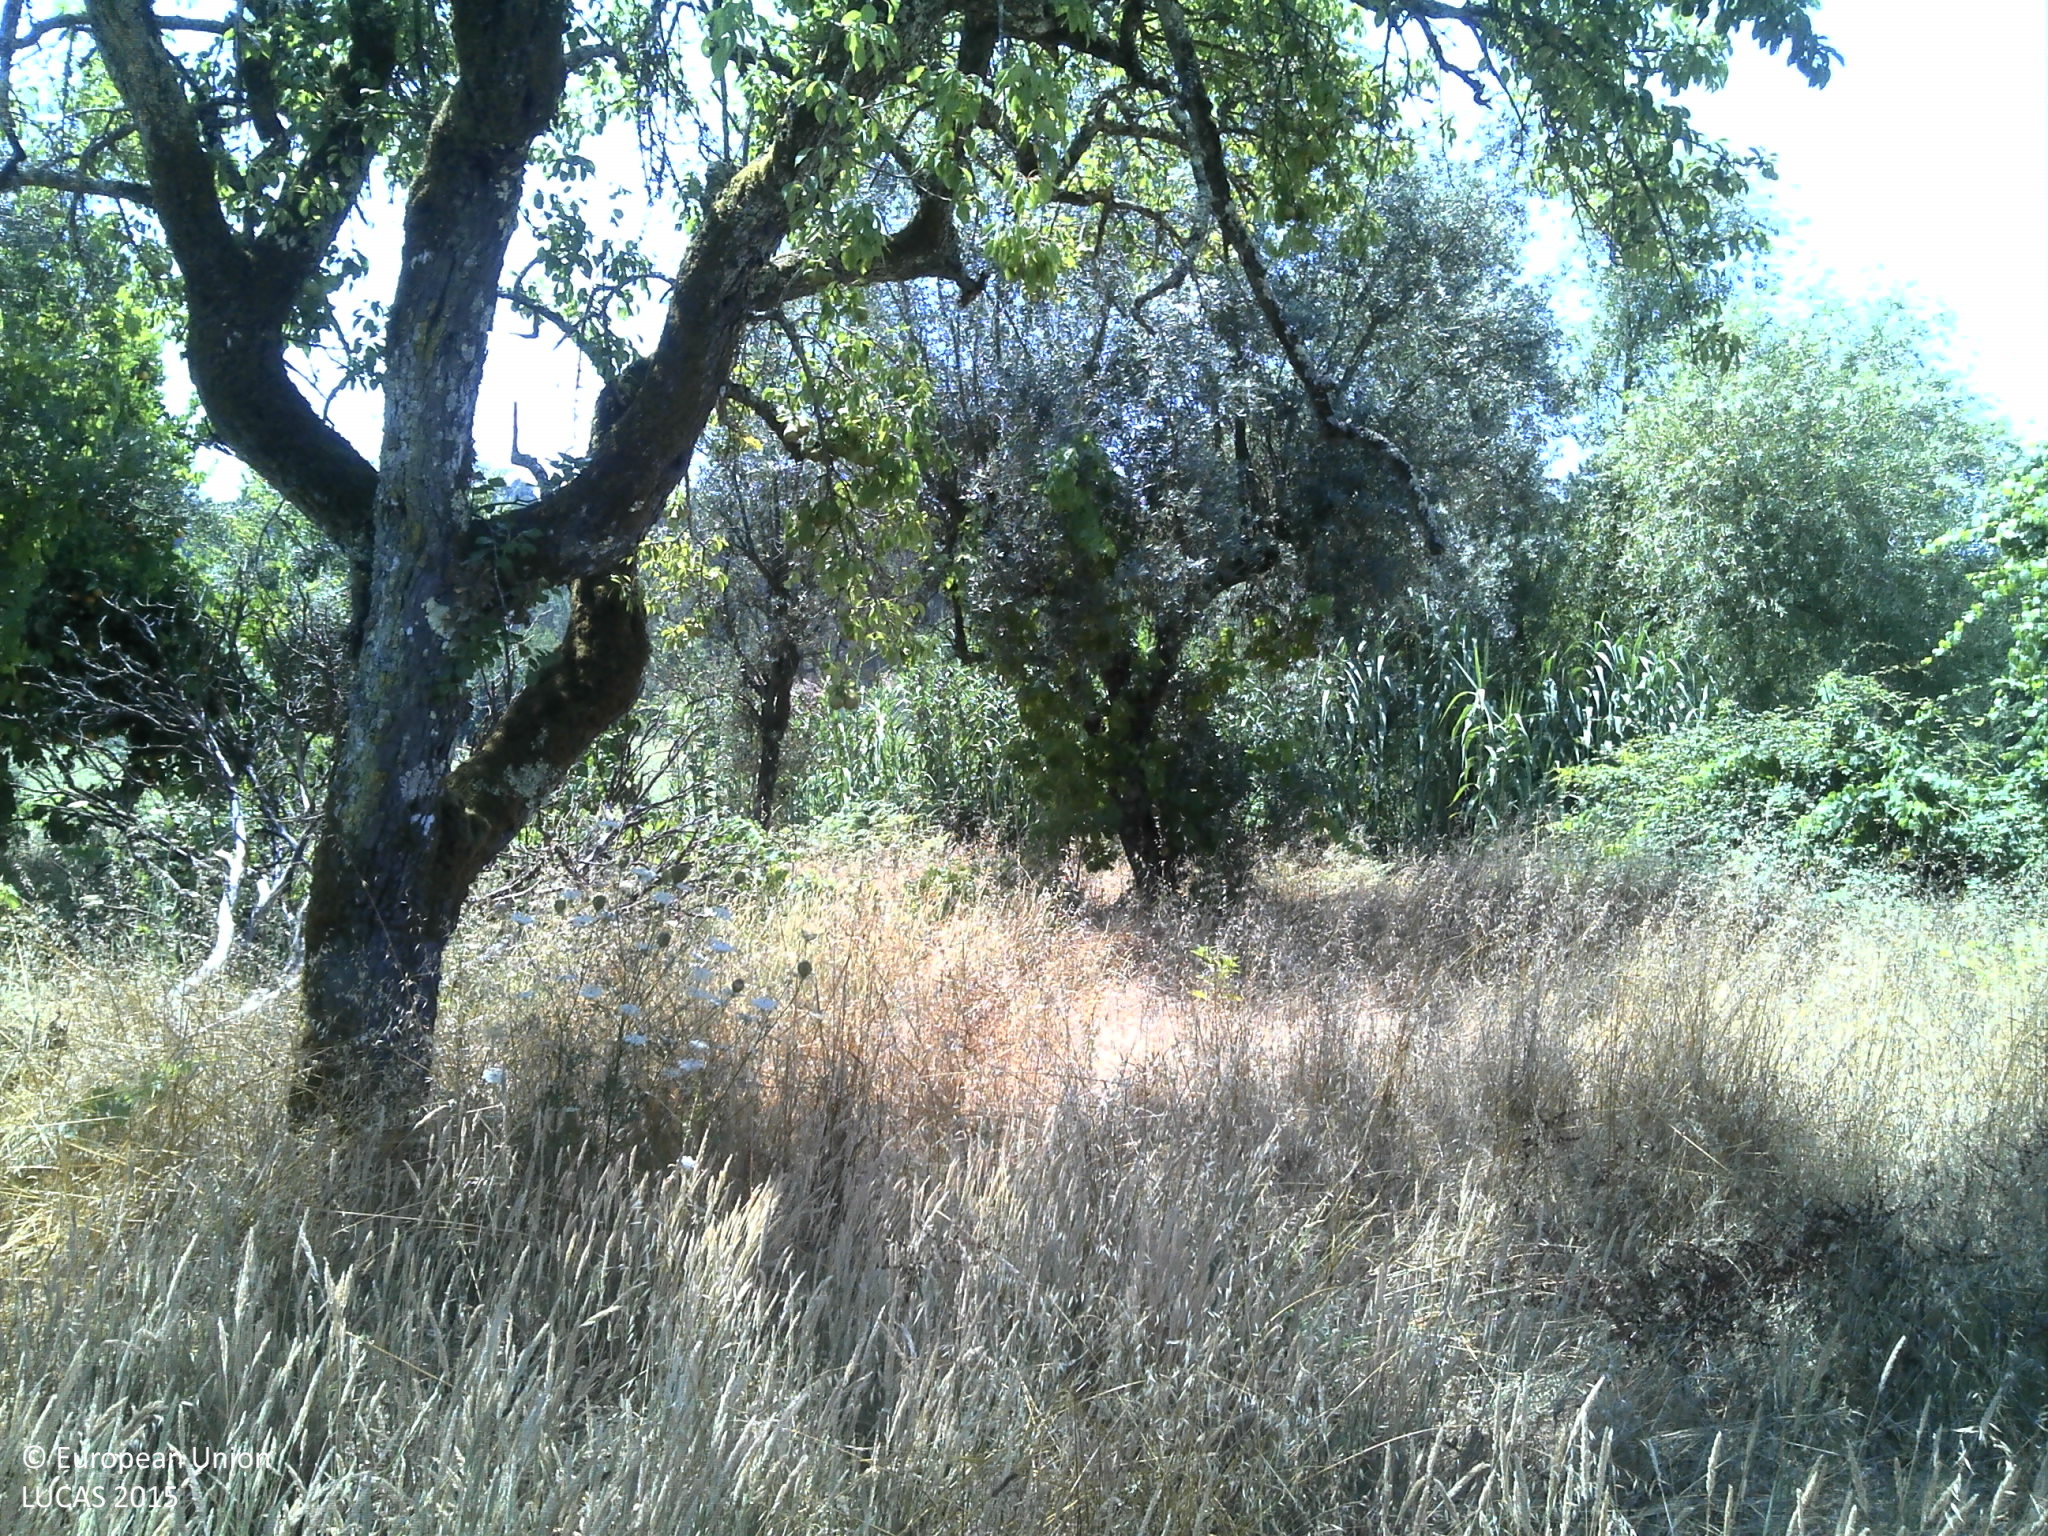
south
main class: Grassland
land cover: Grassland without tree/shrub cover
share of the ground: > 75 %
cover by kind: herbaceous plants 80 %, unconsolidated bare surface 20 %
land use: Agriculture (excluding fallow land and kitchen gardens)
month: July
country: PT
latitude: 40.4730
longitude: -7.9928
